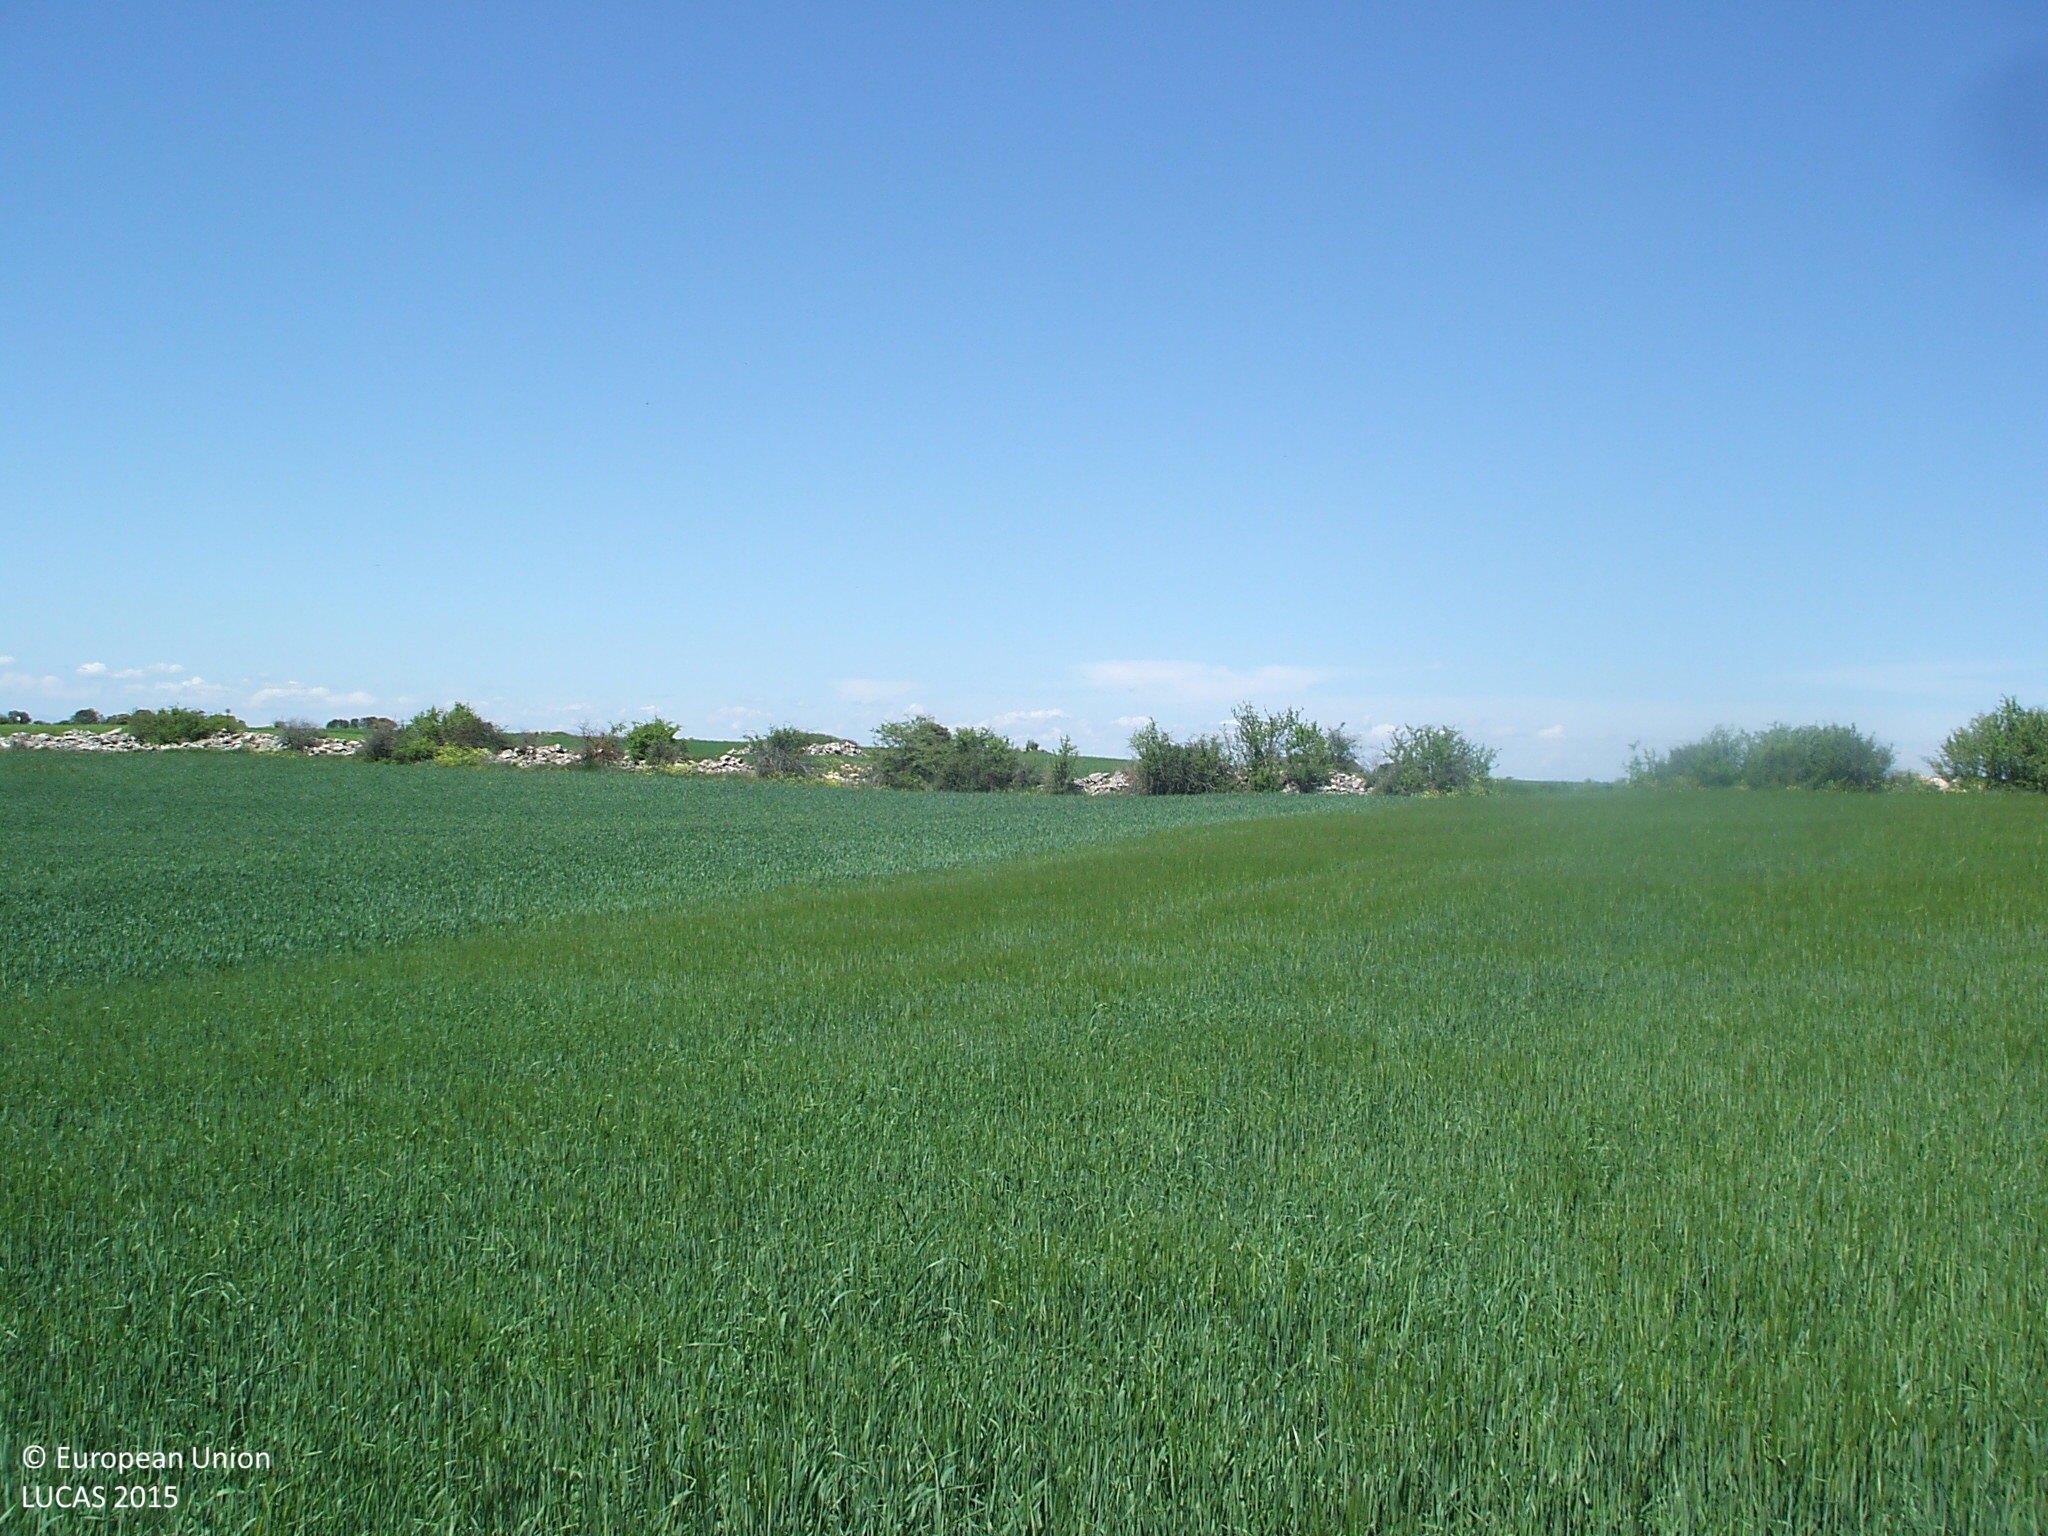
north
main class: Cropland
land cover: Barley
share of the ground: > 75 %
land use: Agriculture (excluding fallow land and kitchen gardens)
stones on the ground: 25 - 50 %
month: May
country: ES
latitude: 40.6838
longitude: -2.9641
